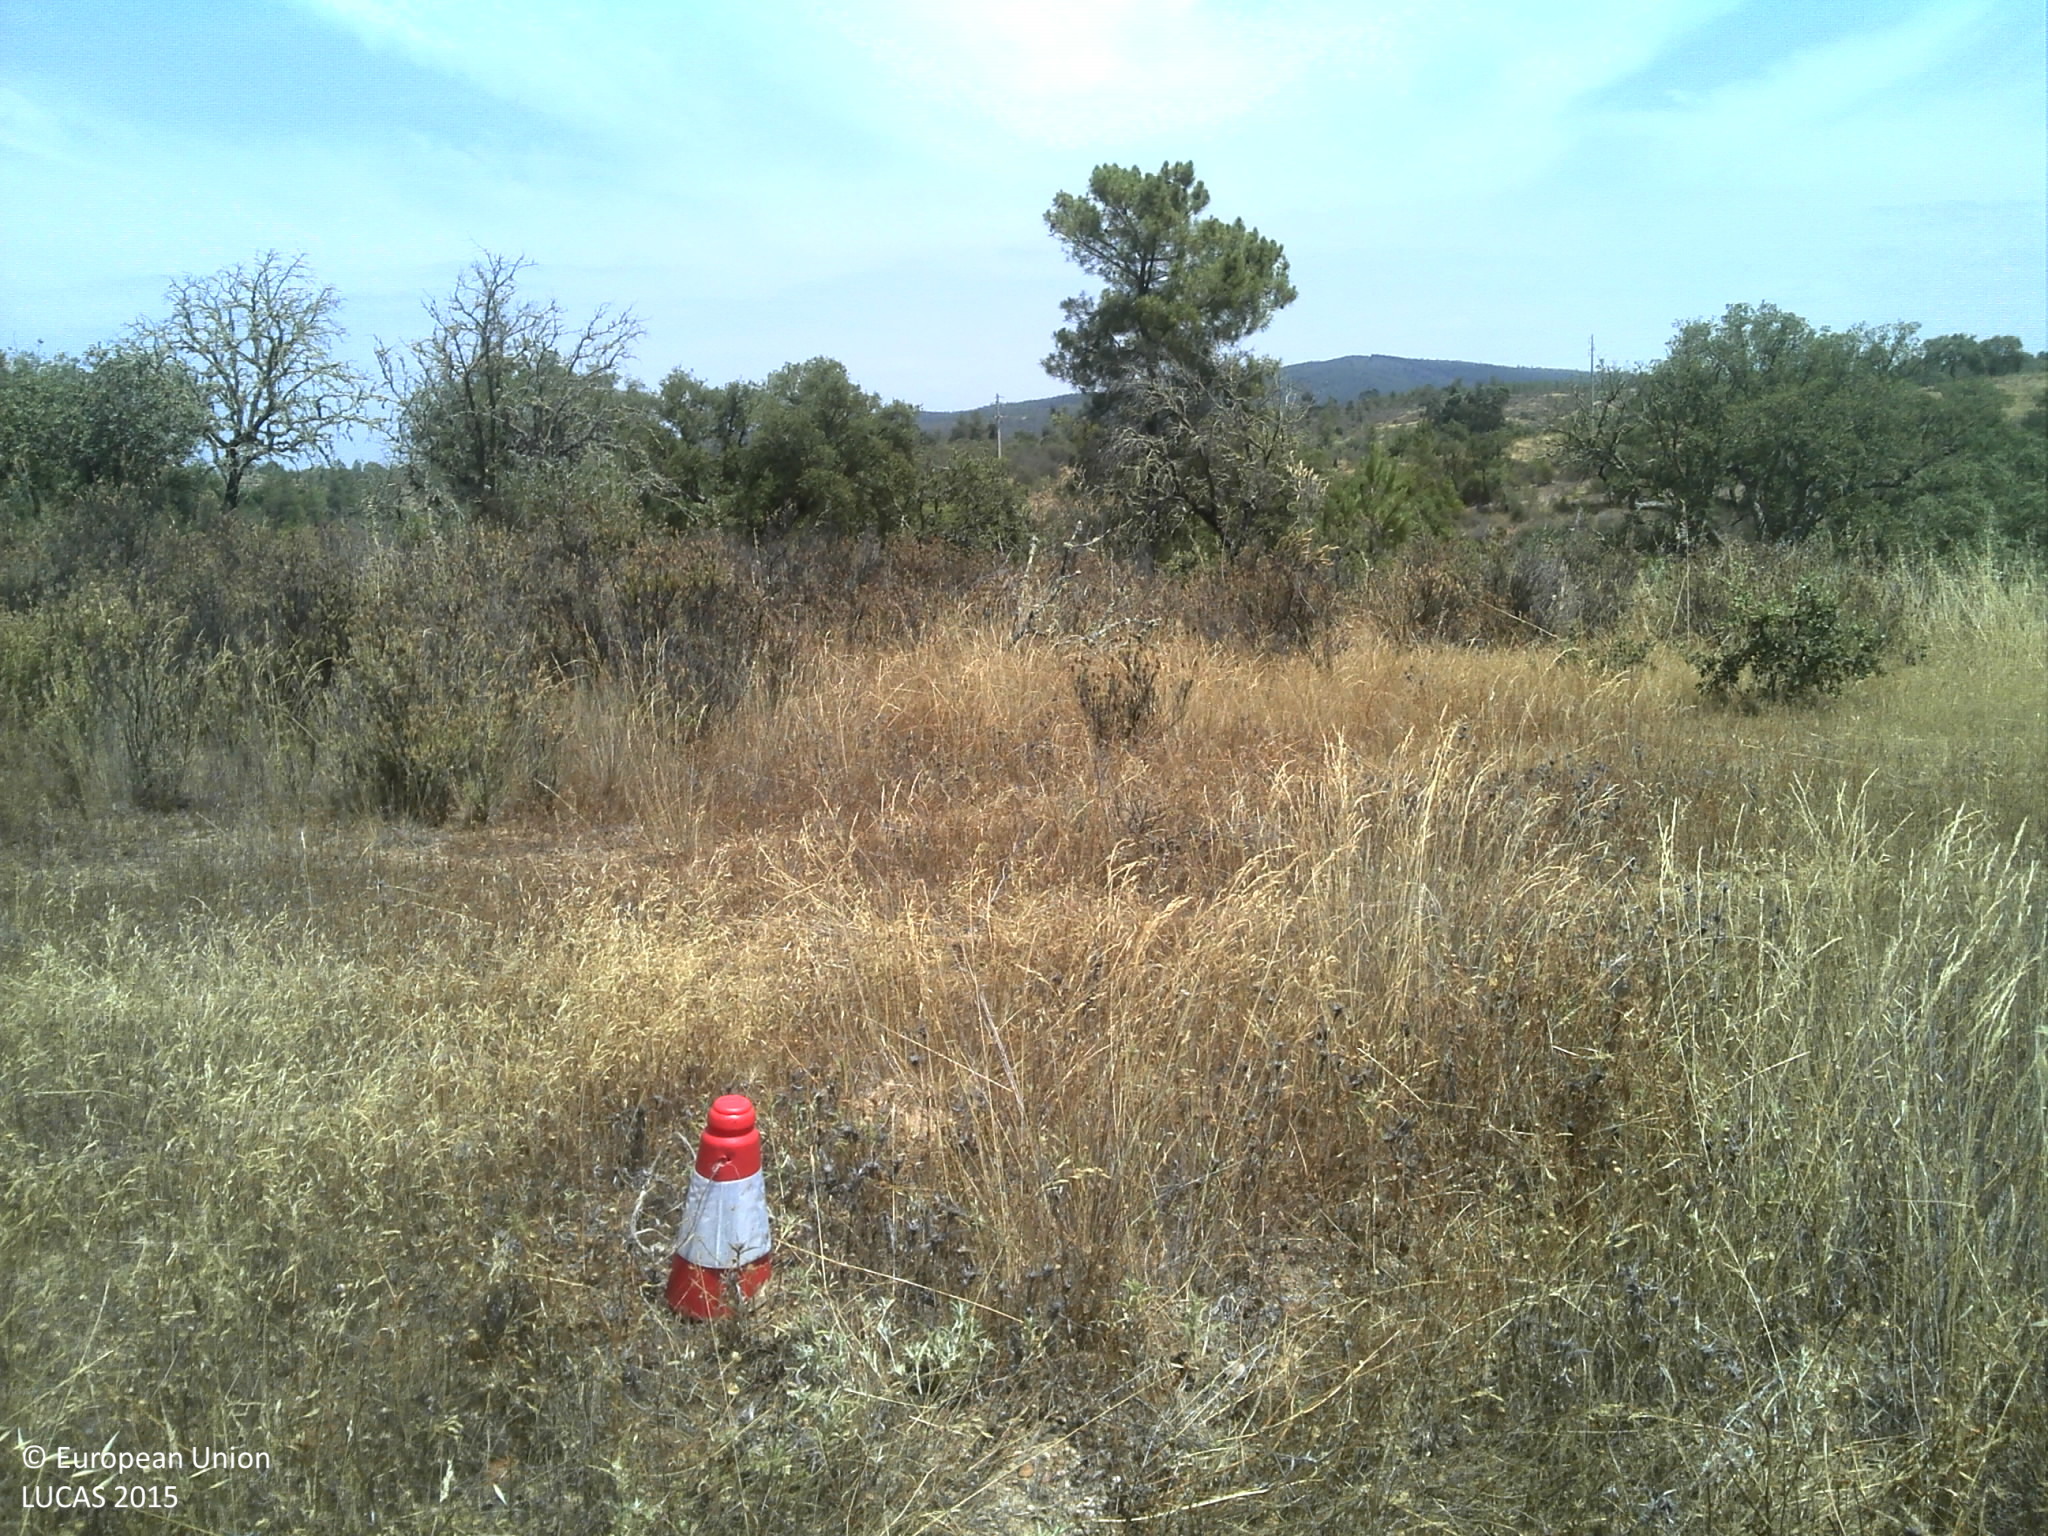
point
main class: Grassland
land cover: Grassland without tree/shrub cover
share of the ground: 25 - 50 %
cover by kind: unconsolidated bare surface 55 %, herbaceous plants 45 %
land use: Agriculture (excluding fallow land and kitchen gardens)
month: June
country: PT
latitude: 39.9253
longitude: -7.0443
